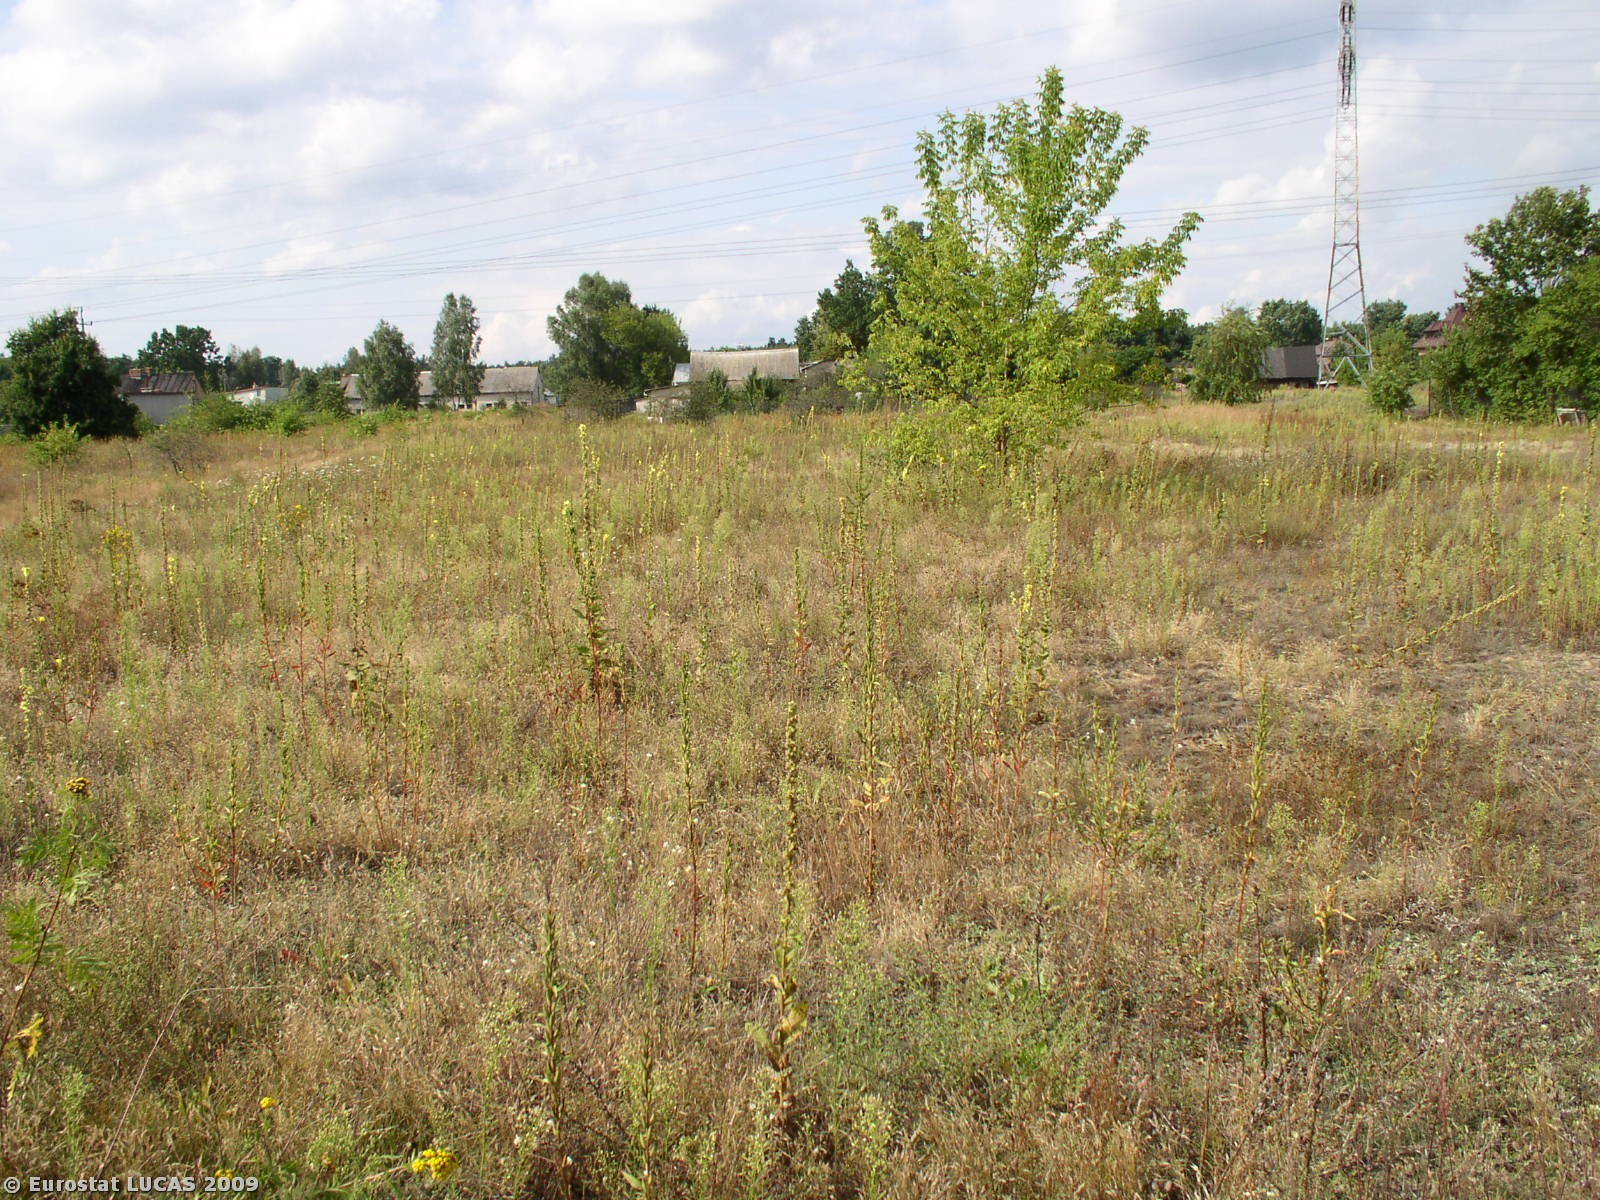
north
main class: Grassland
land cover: Spontaneously vegetated surfaces
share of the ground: > 75 %
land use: Unused
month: August
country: PL
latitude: 52.2402
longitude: 21.2506
